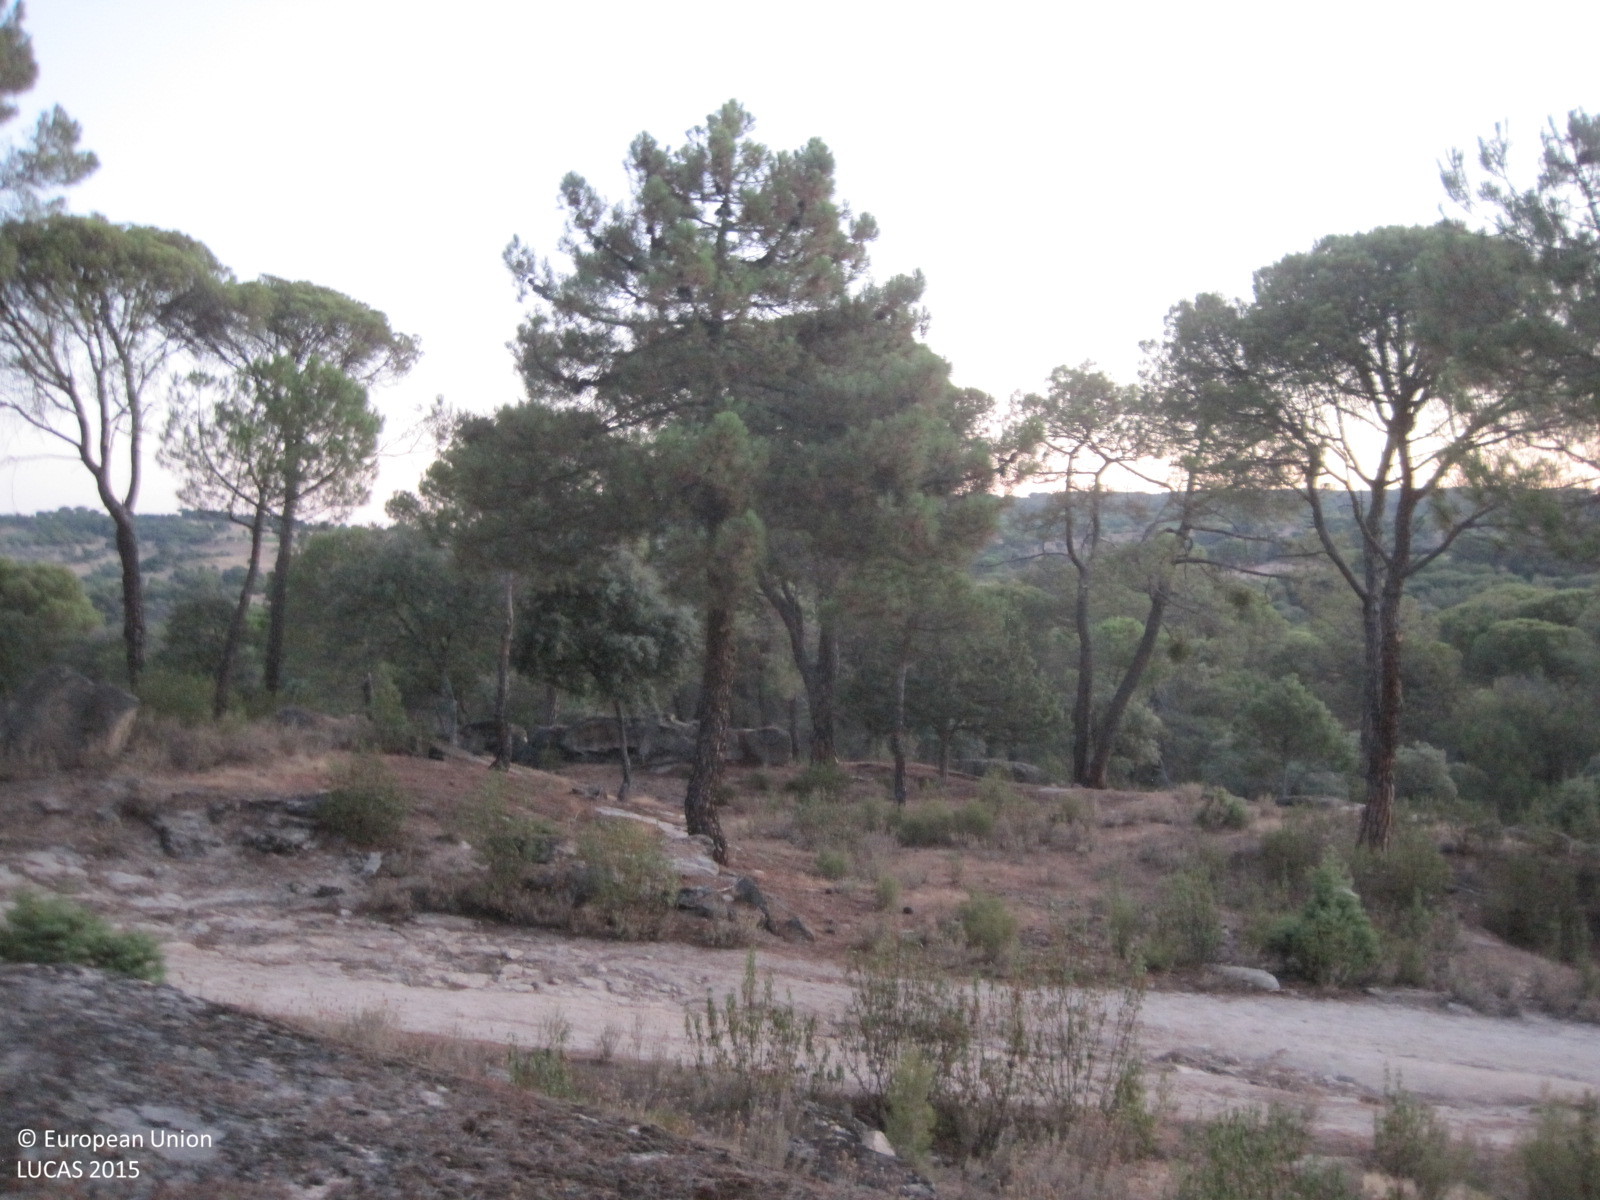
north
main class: Woodland
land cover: Pine dominated coniferous woodland
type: coniferous forest of the mediterranean region
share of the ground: > 75 %
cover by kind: coniferous forest trees 80 %, shrubs 20 %
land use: Forestry
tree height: > 5 m
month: July
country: ES
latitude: 40.3190
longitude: -4.3915
